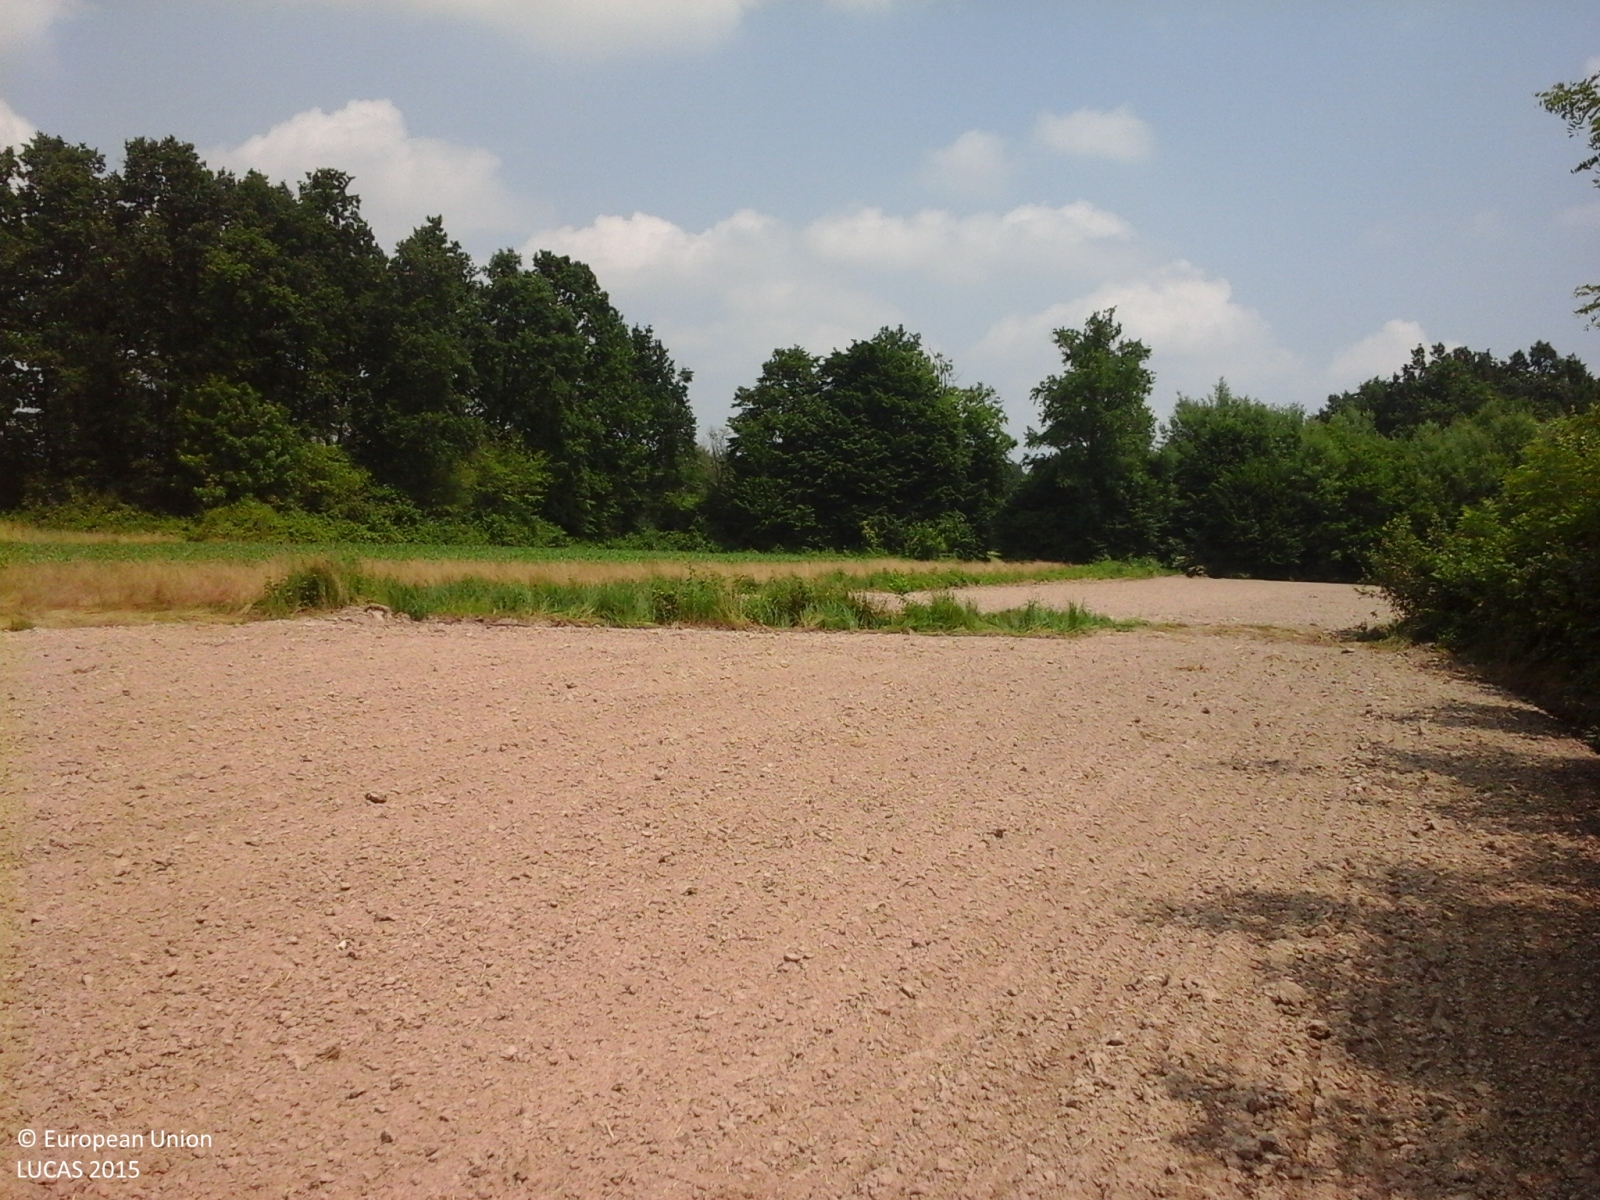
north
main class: Cropland
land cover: Soya
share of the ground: > 75 %
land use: Agriculture (excluding fallow land and kitchen gardens)
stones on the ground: < 10 %
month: May
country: IT
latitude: 45.2460
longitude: 7.7487
